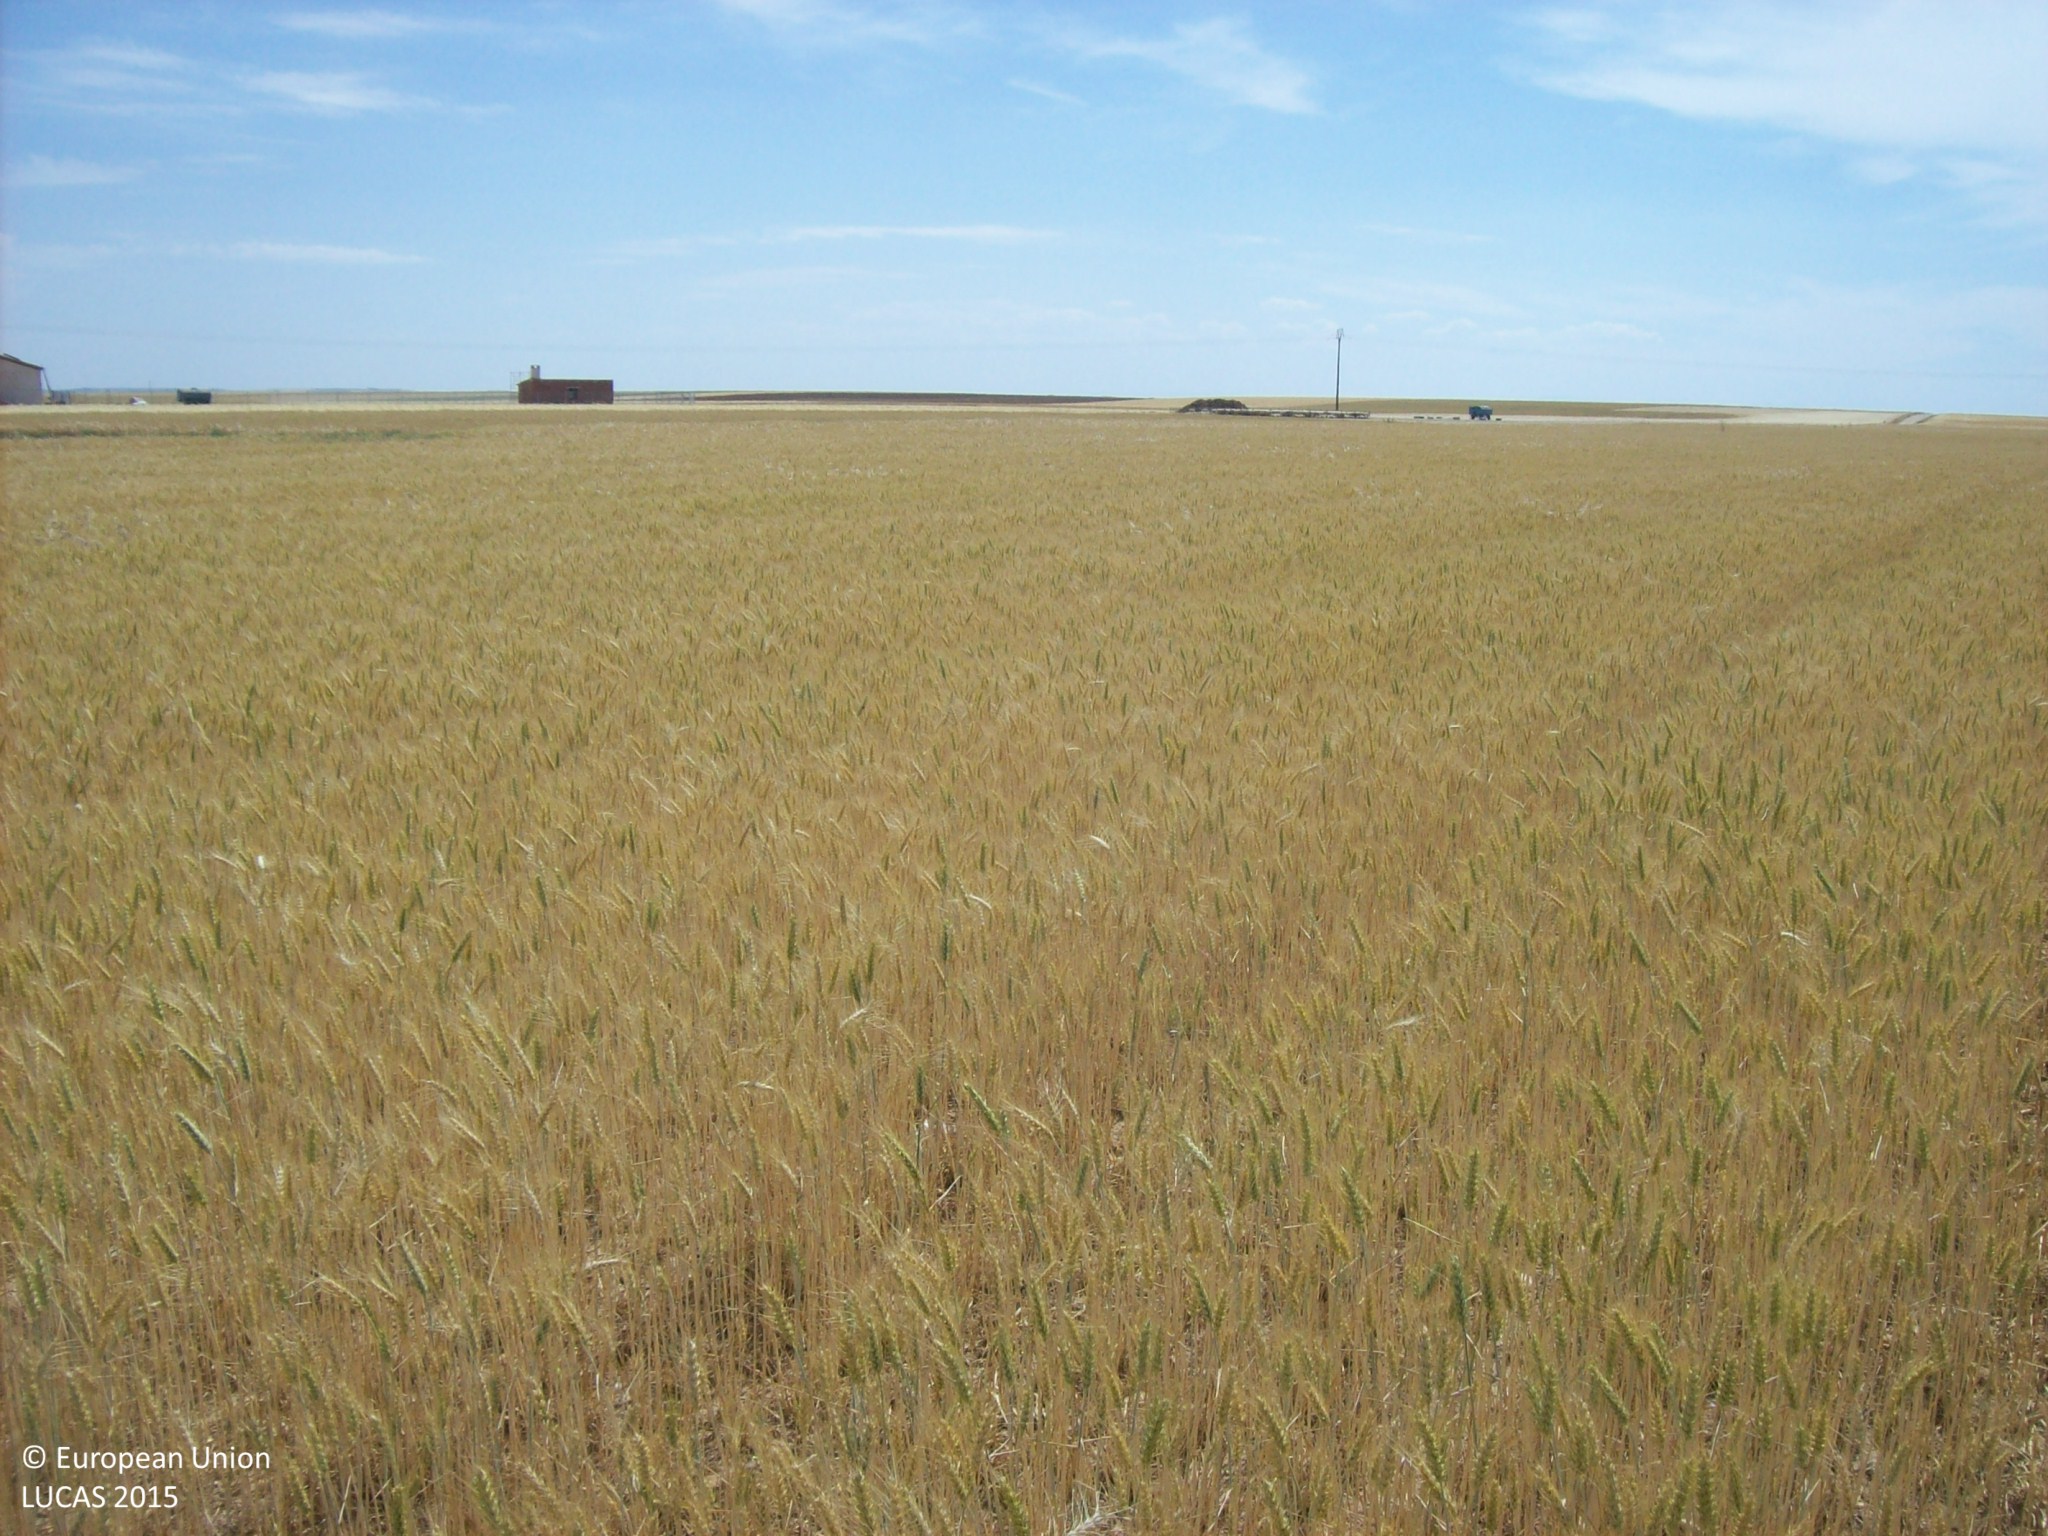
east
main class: Cropland
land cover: Common wheat
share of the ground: > 75 %
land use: Agriculture (excluding fallow land and kitchen gardens)
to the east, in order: Common wheat; Grass margins; Tracks; Grass margins; Common wheat; Grass margins; Barley; Tracks; Common wheat
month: June
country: ES
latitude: 41.0531
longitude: -4.9981
